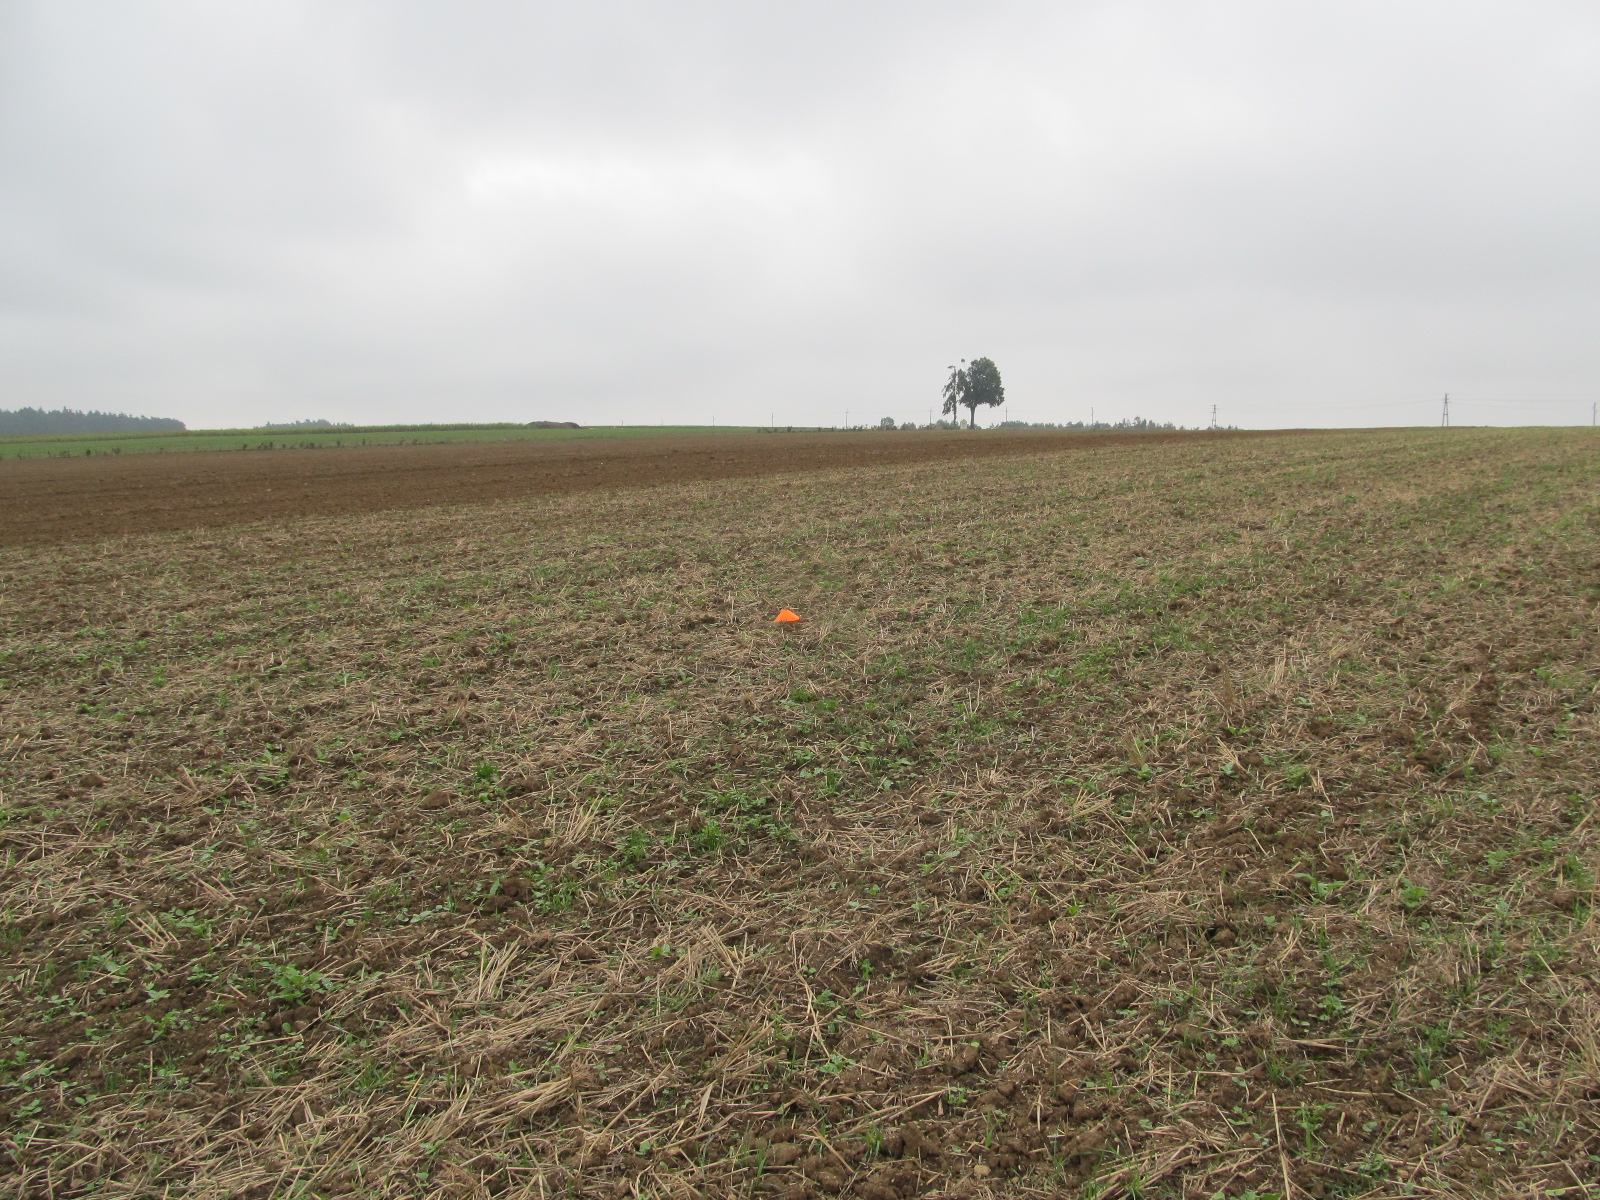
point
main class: Cropland
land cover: Common wheat
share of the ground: 25 - 50 %
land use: Agriculture (excluding fallow land and kitchen gardens)
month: September
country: AT
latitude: 48.8951
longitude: 15.5549
